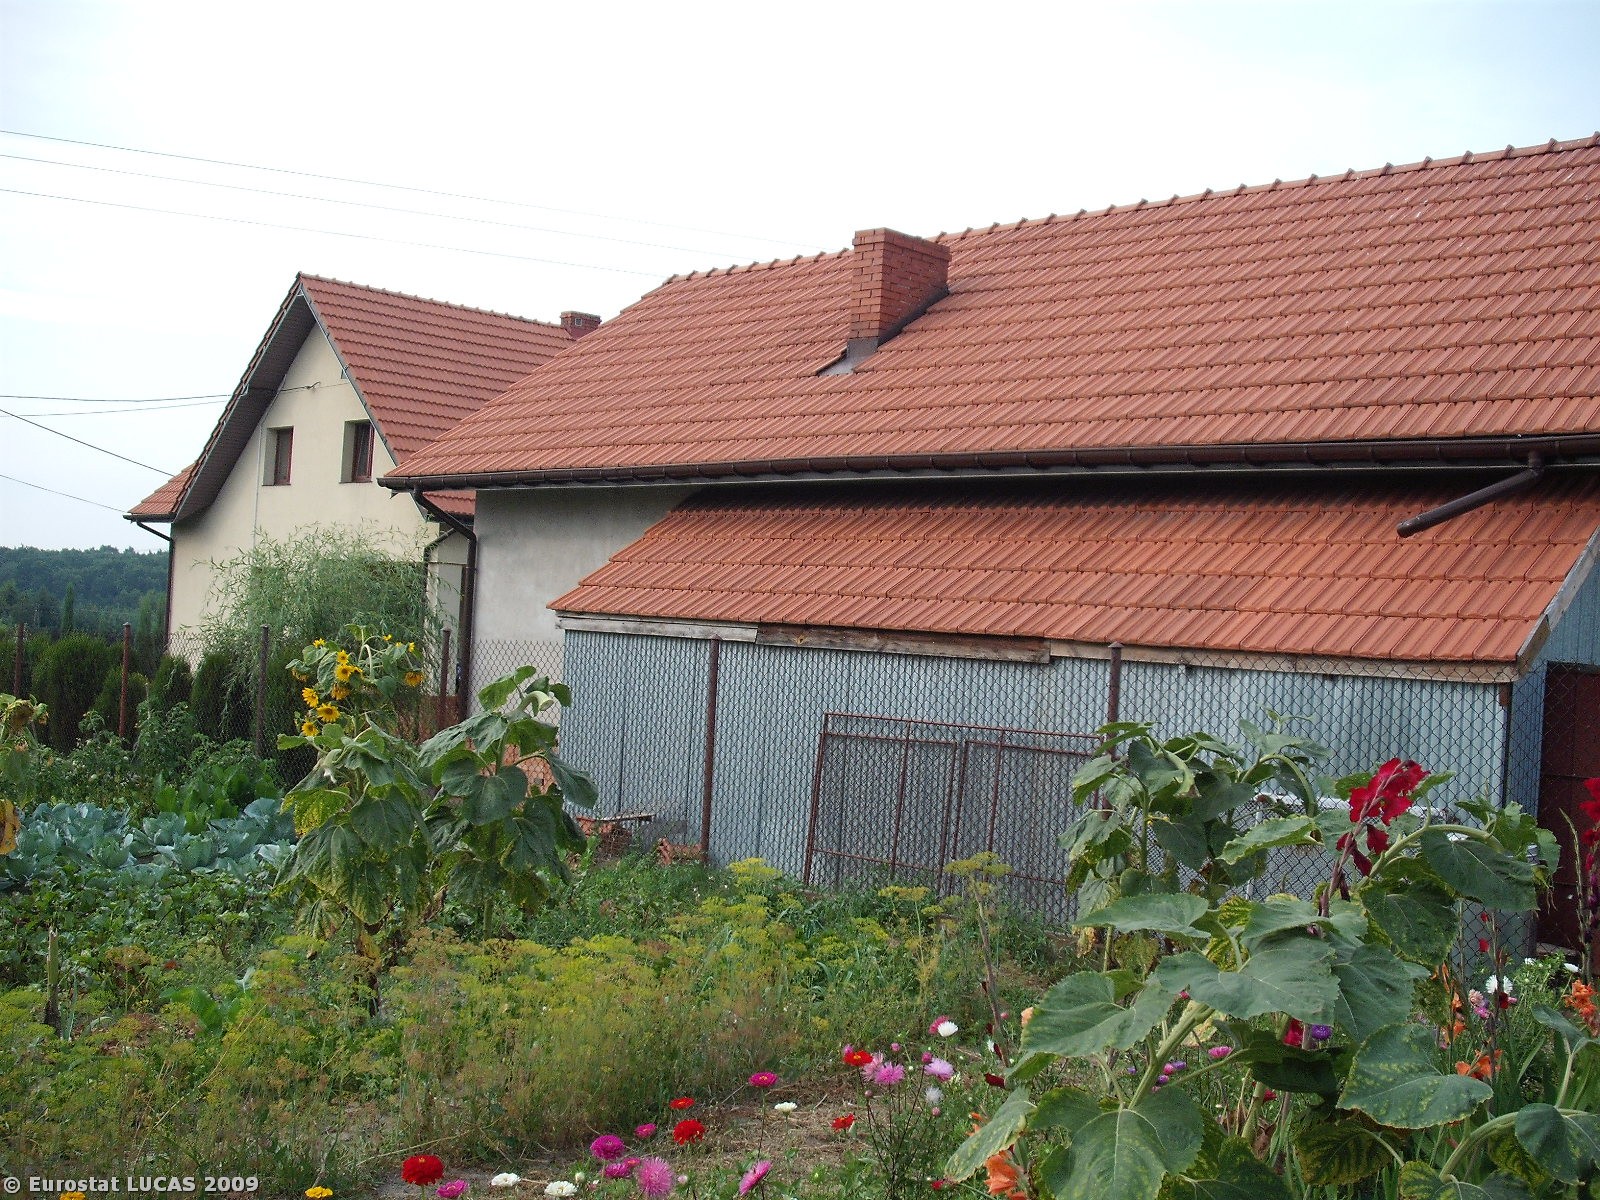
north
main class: Cropland
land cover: Other fresh vegetables
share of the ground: 50 - 75 %
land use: Kitchen garden
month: August
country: PL
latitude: 50.4767
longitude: 20.7076
